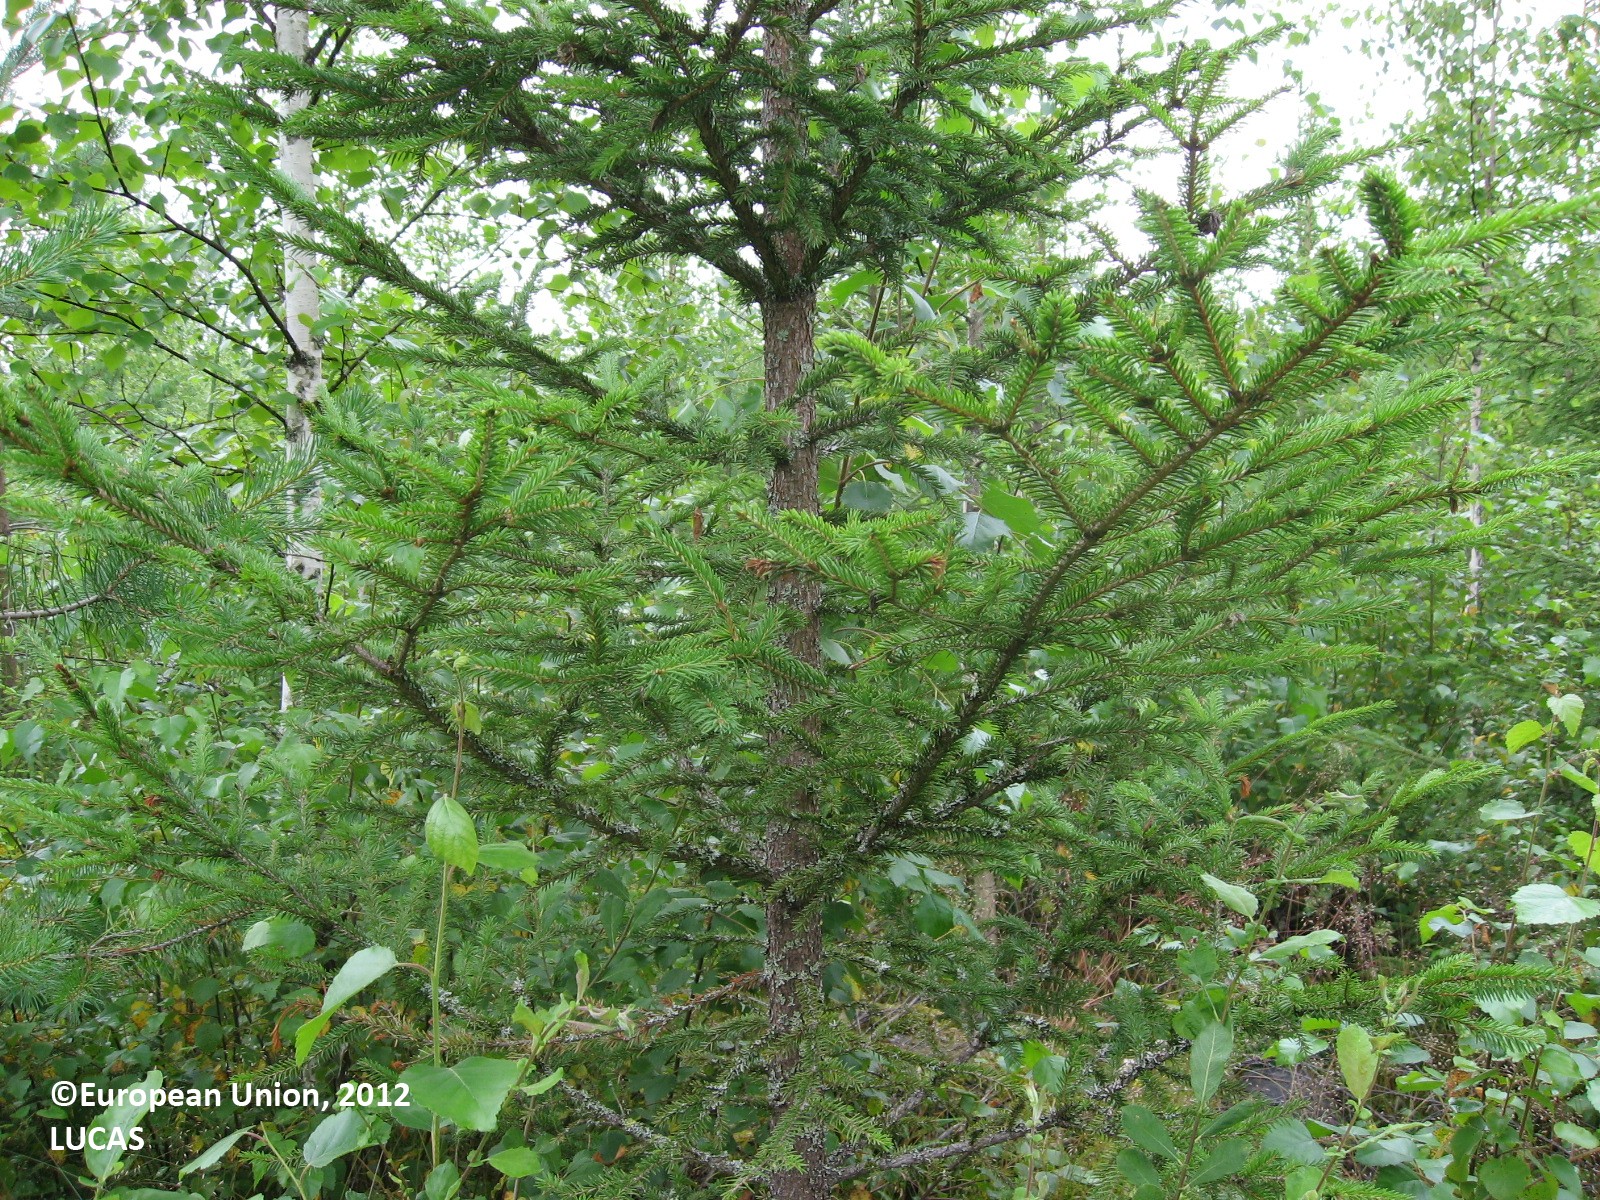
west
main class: Woodland
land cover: Spruce dominated mixed woodland
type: boreal forest
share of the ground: > 75 %
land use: Forestry
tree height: < 5 m
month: July
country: FI
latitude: 61.3844
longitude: 25.9497
